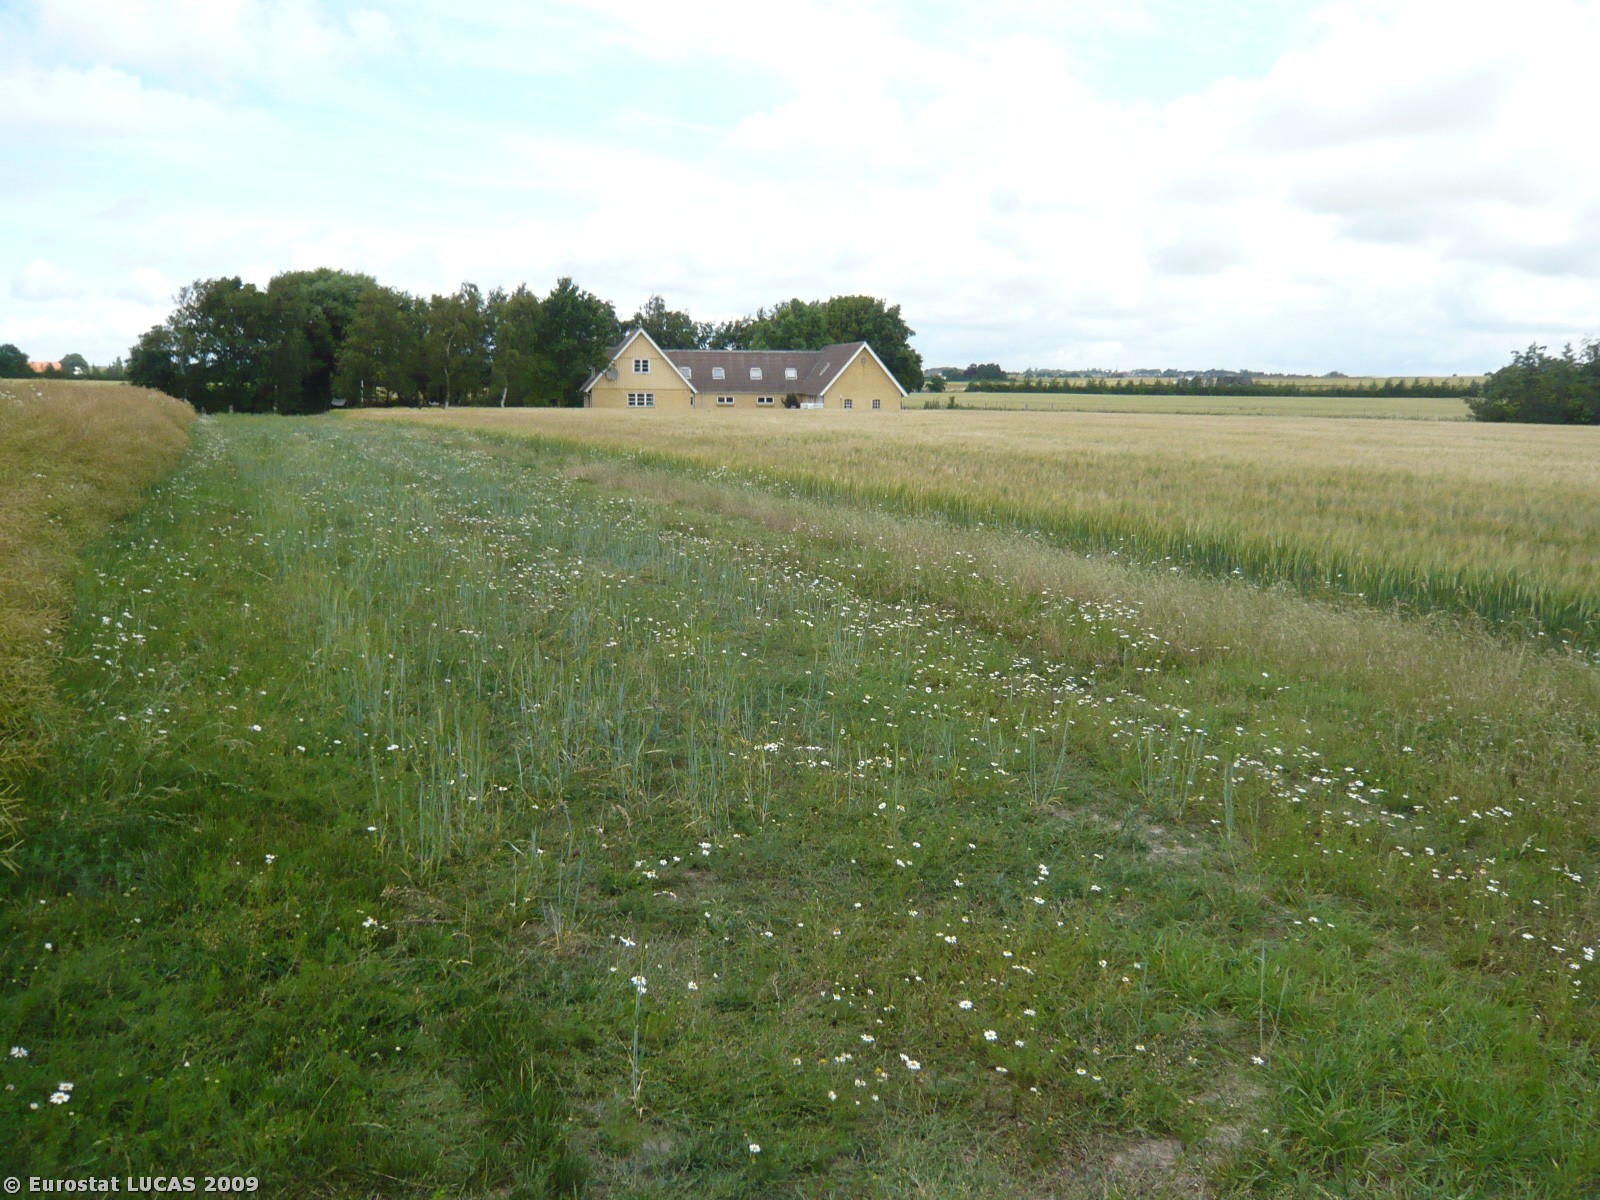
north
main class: Cropland
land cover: Rape and turnip rape
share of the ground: > 75 %
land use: Agriculture (excluding fallow land and kitchen gardens)
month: July
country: DK
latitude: 55.4090
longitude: 11.2151
